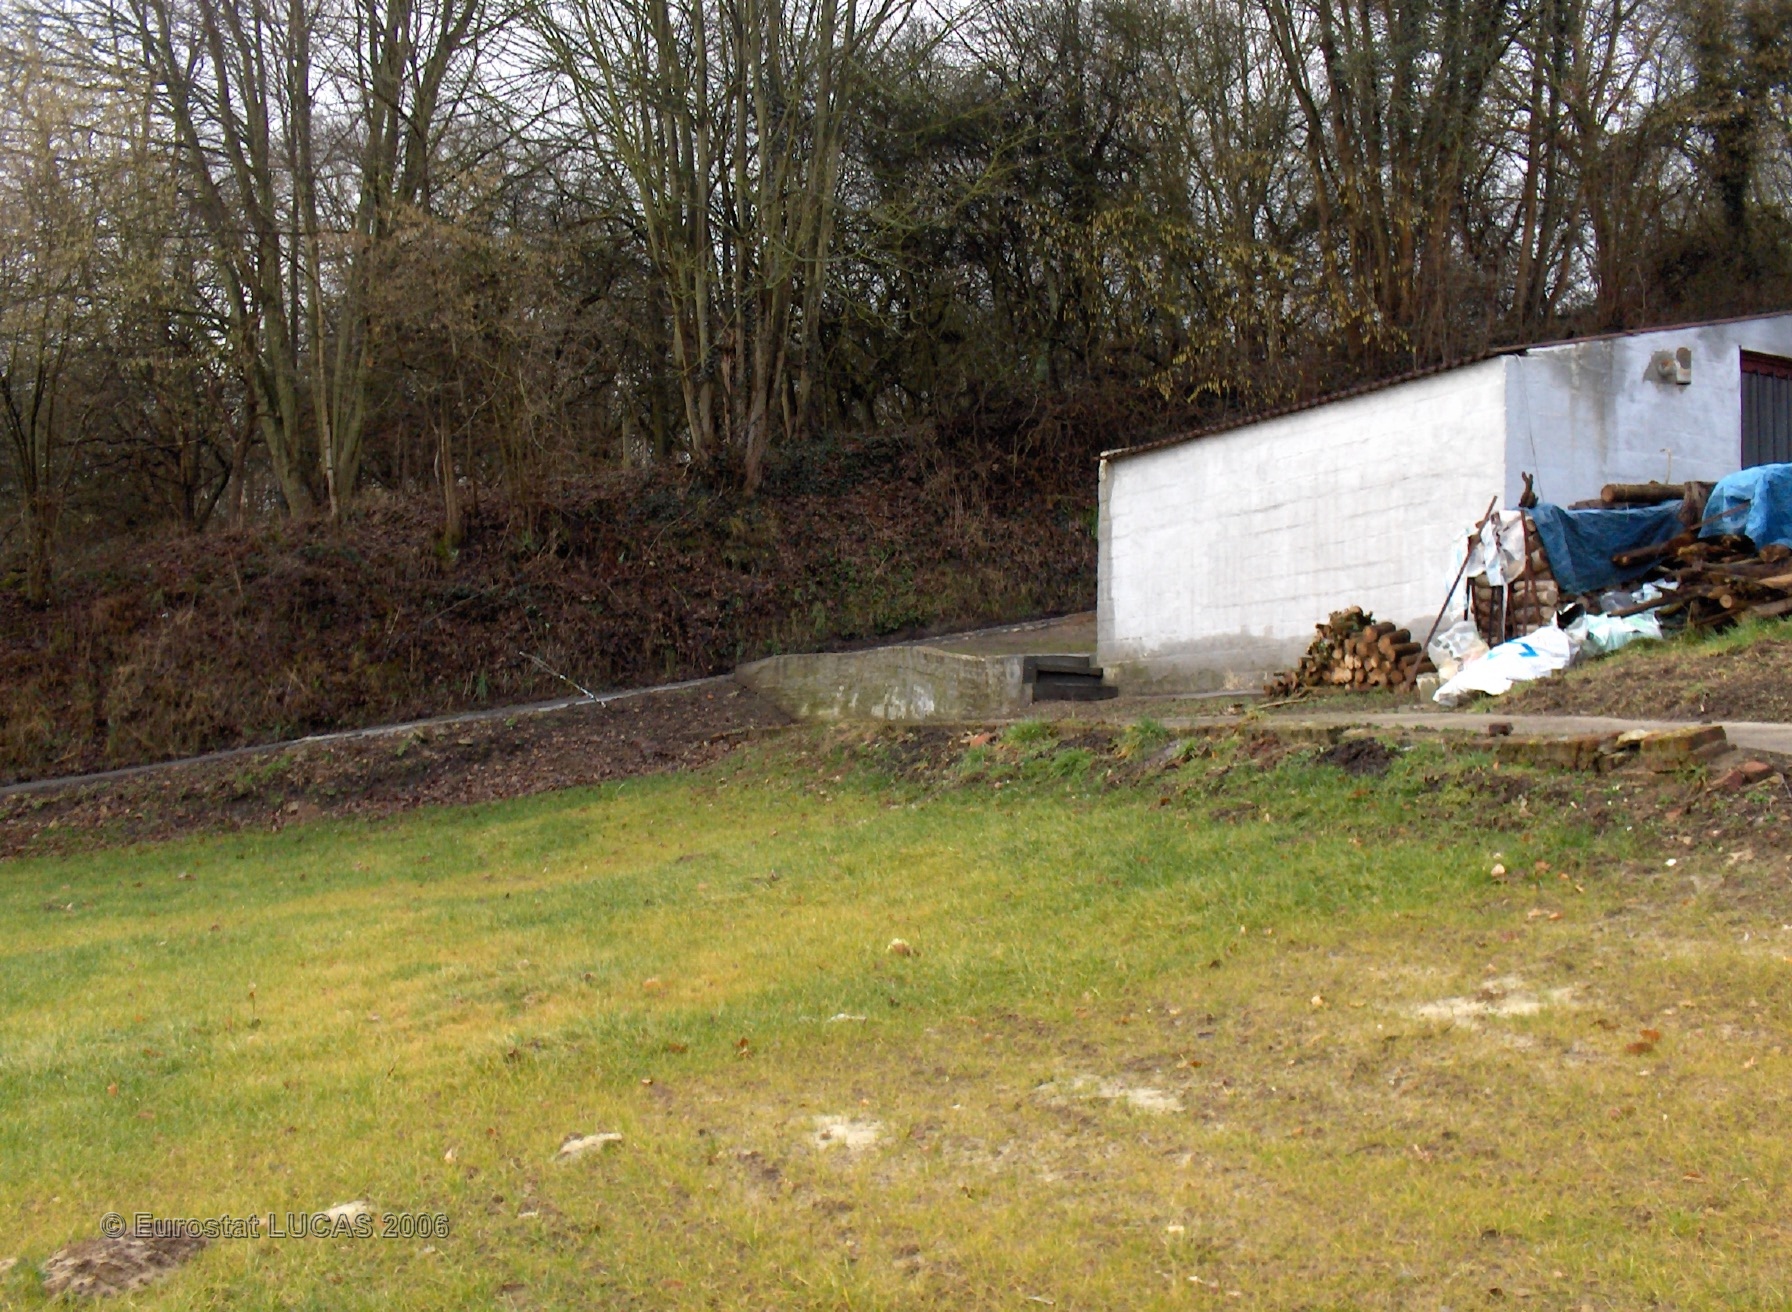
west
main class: Grassland
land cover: Grassland without tree/shrub cover
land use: Agriculture (excluding fallow land and kitchen gardens)
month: February
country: BE
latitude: 50.7728
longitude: 4.5080
